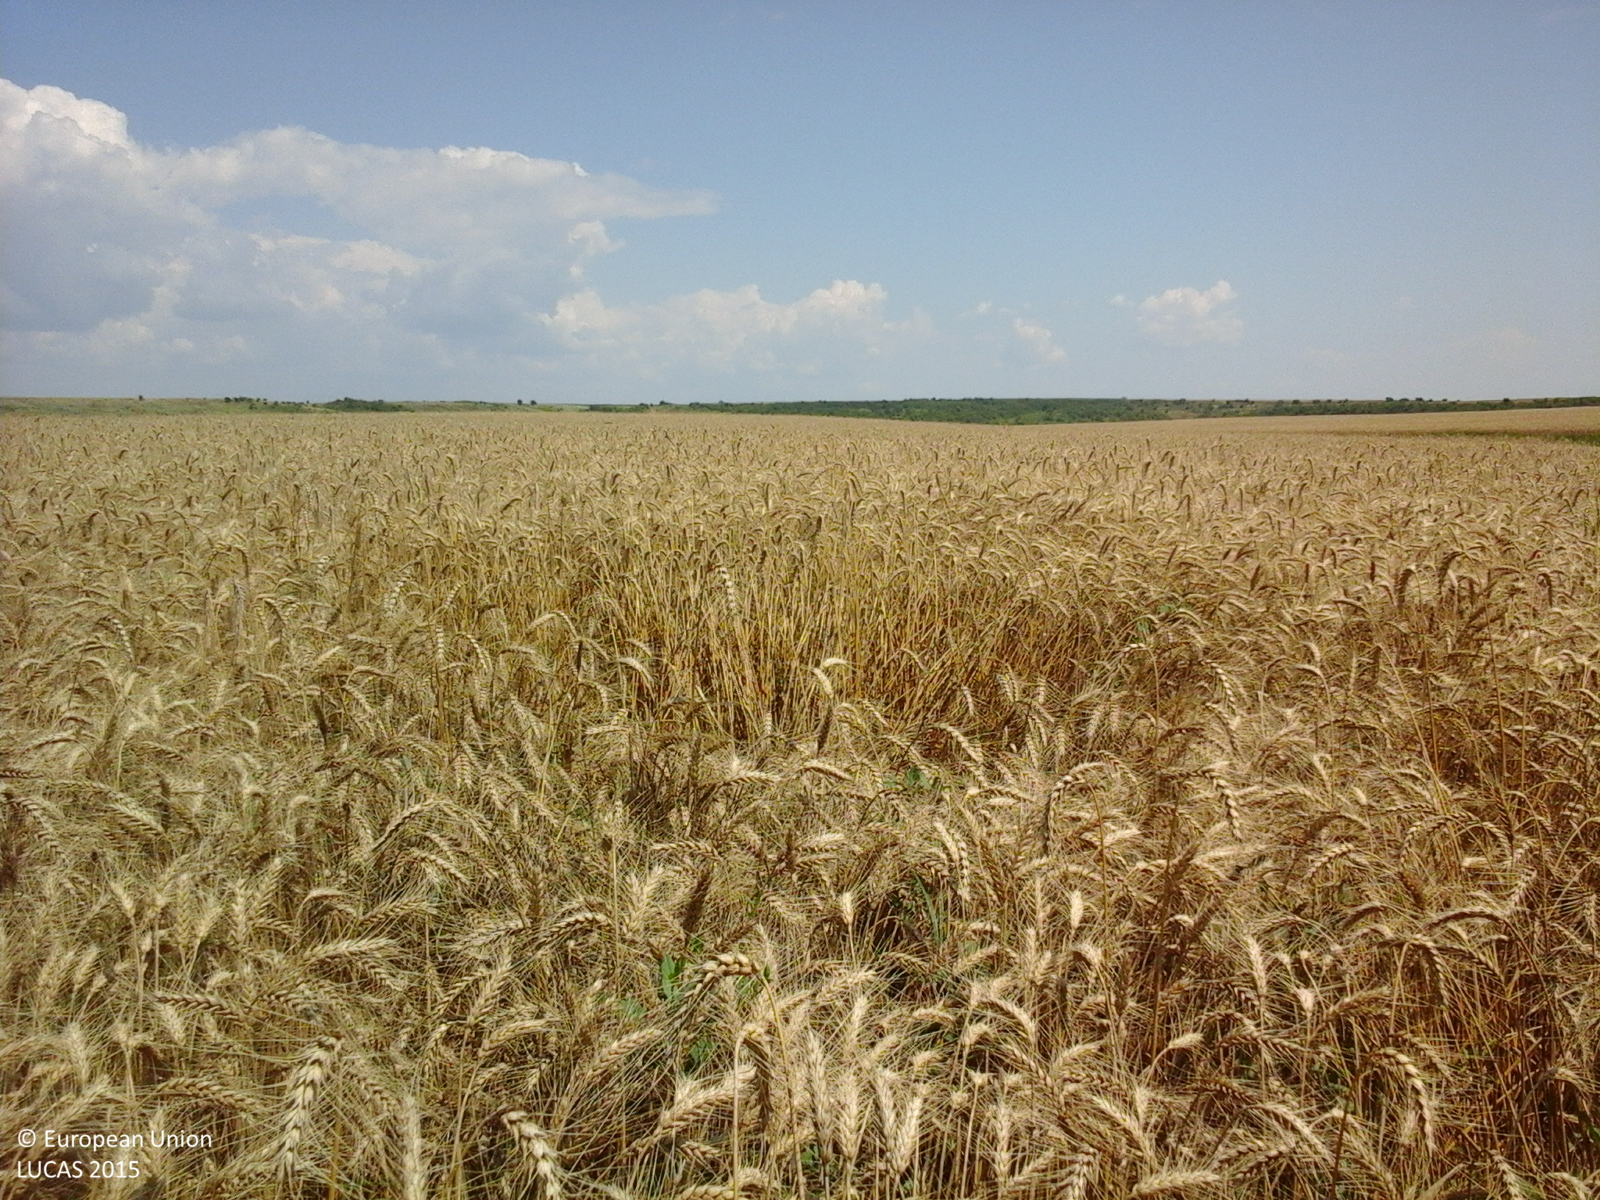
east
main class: Cropland
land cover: Common wheat
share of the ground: > 75 %
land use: Agriculture (excluding fallow land and kitchen gardens)
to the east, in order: Common wheat
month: July
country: RO
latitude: 44.2069
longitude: 25.7245
